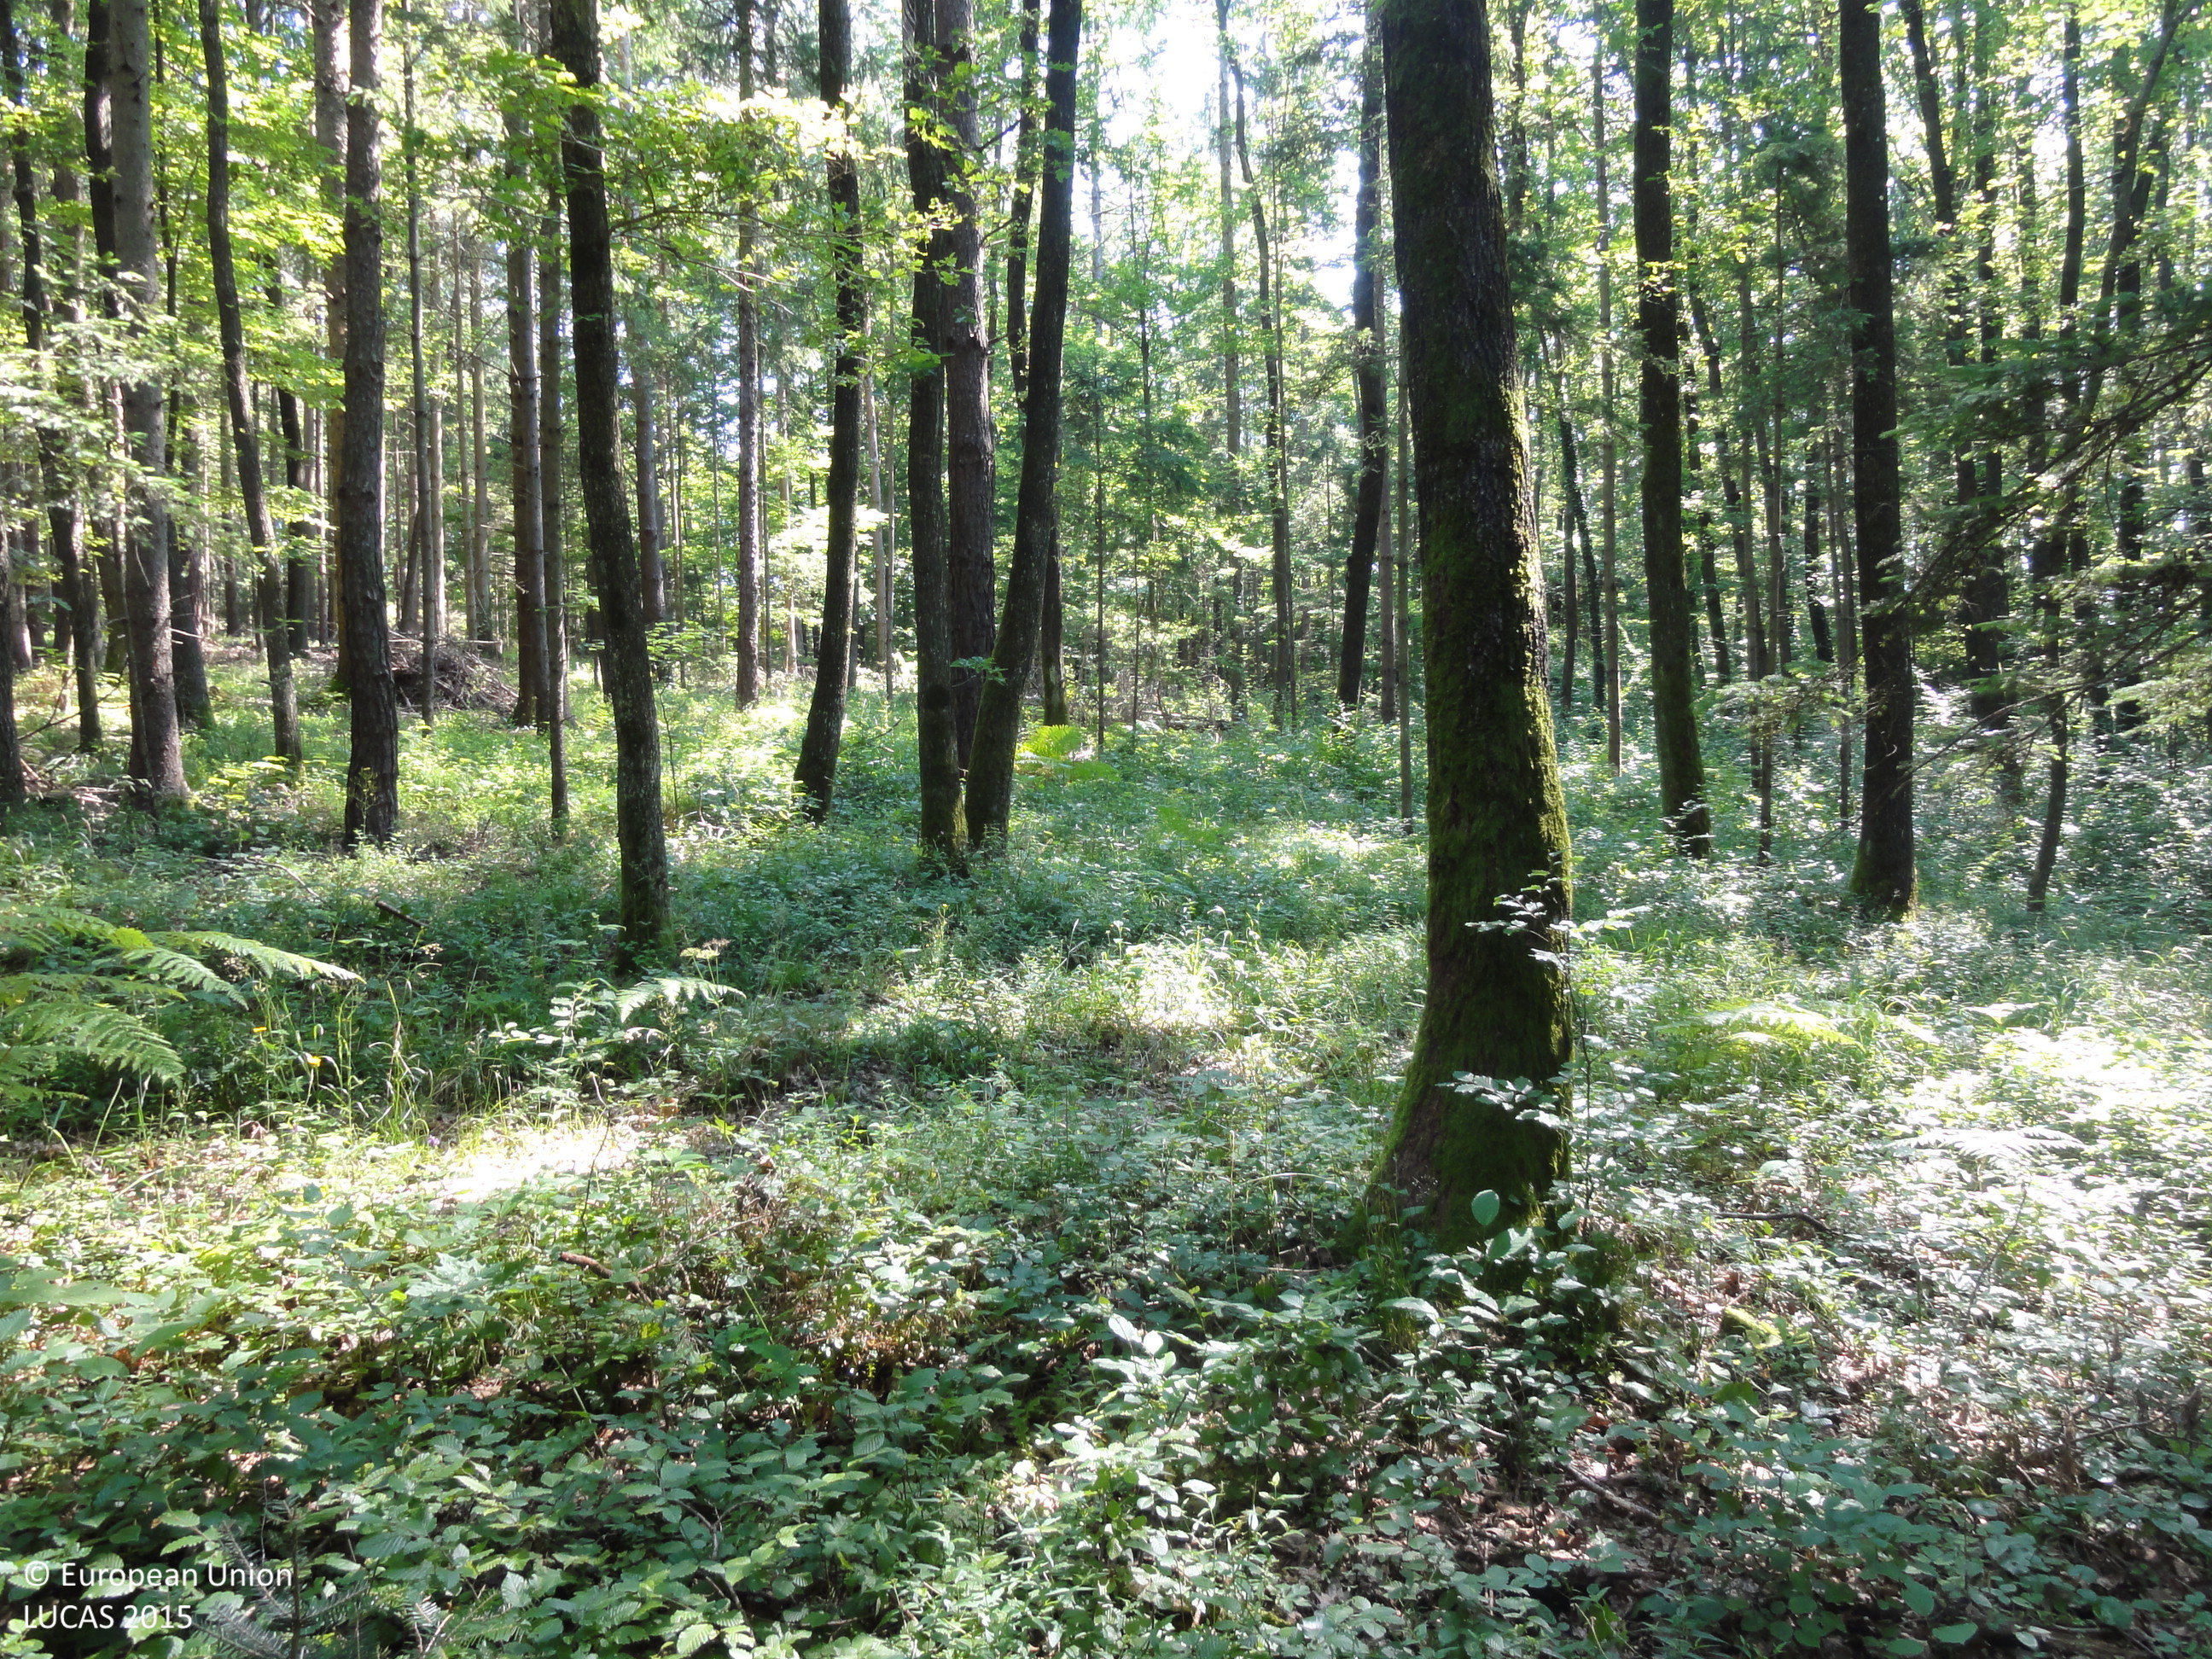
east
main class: Woodland
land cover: Spruce dominated mixed woodland
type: hemiboreal forest and nemoral coniferous forest and mixed broadleaved-coniferous forest
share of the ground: > 75 %
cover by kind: coniferous forest trees 60 %, broadleaved forest trees 40 %
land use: Forestry
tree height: > 5 m
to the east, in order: Spruce dominated mixed woodland; Tracks; Spruce dominated mixed woodland; Rivers and streams; Tracks; Spruce dominated mixed woodland; Fences; Spruce dominated mixed woodland; Grassland without tree/shrub cover; Tracks; Grassland without tree/shrub cover; Shrubland with sparse tree cover
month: July
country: SI
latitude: 46.3889
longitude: 15.5251
